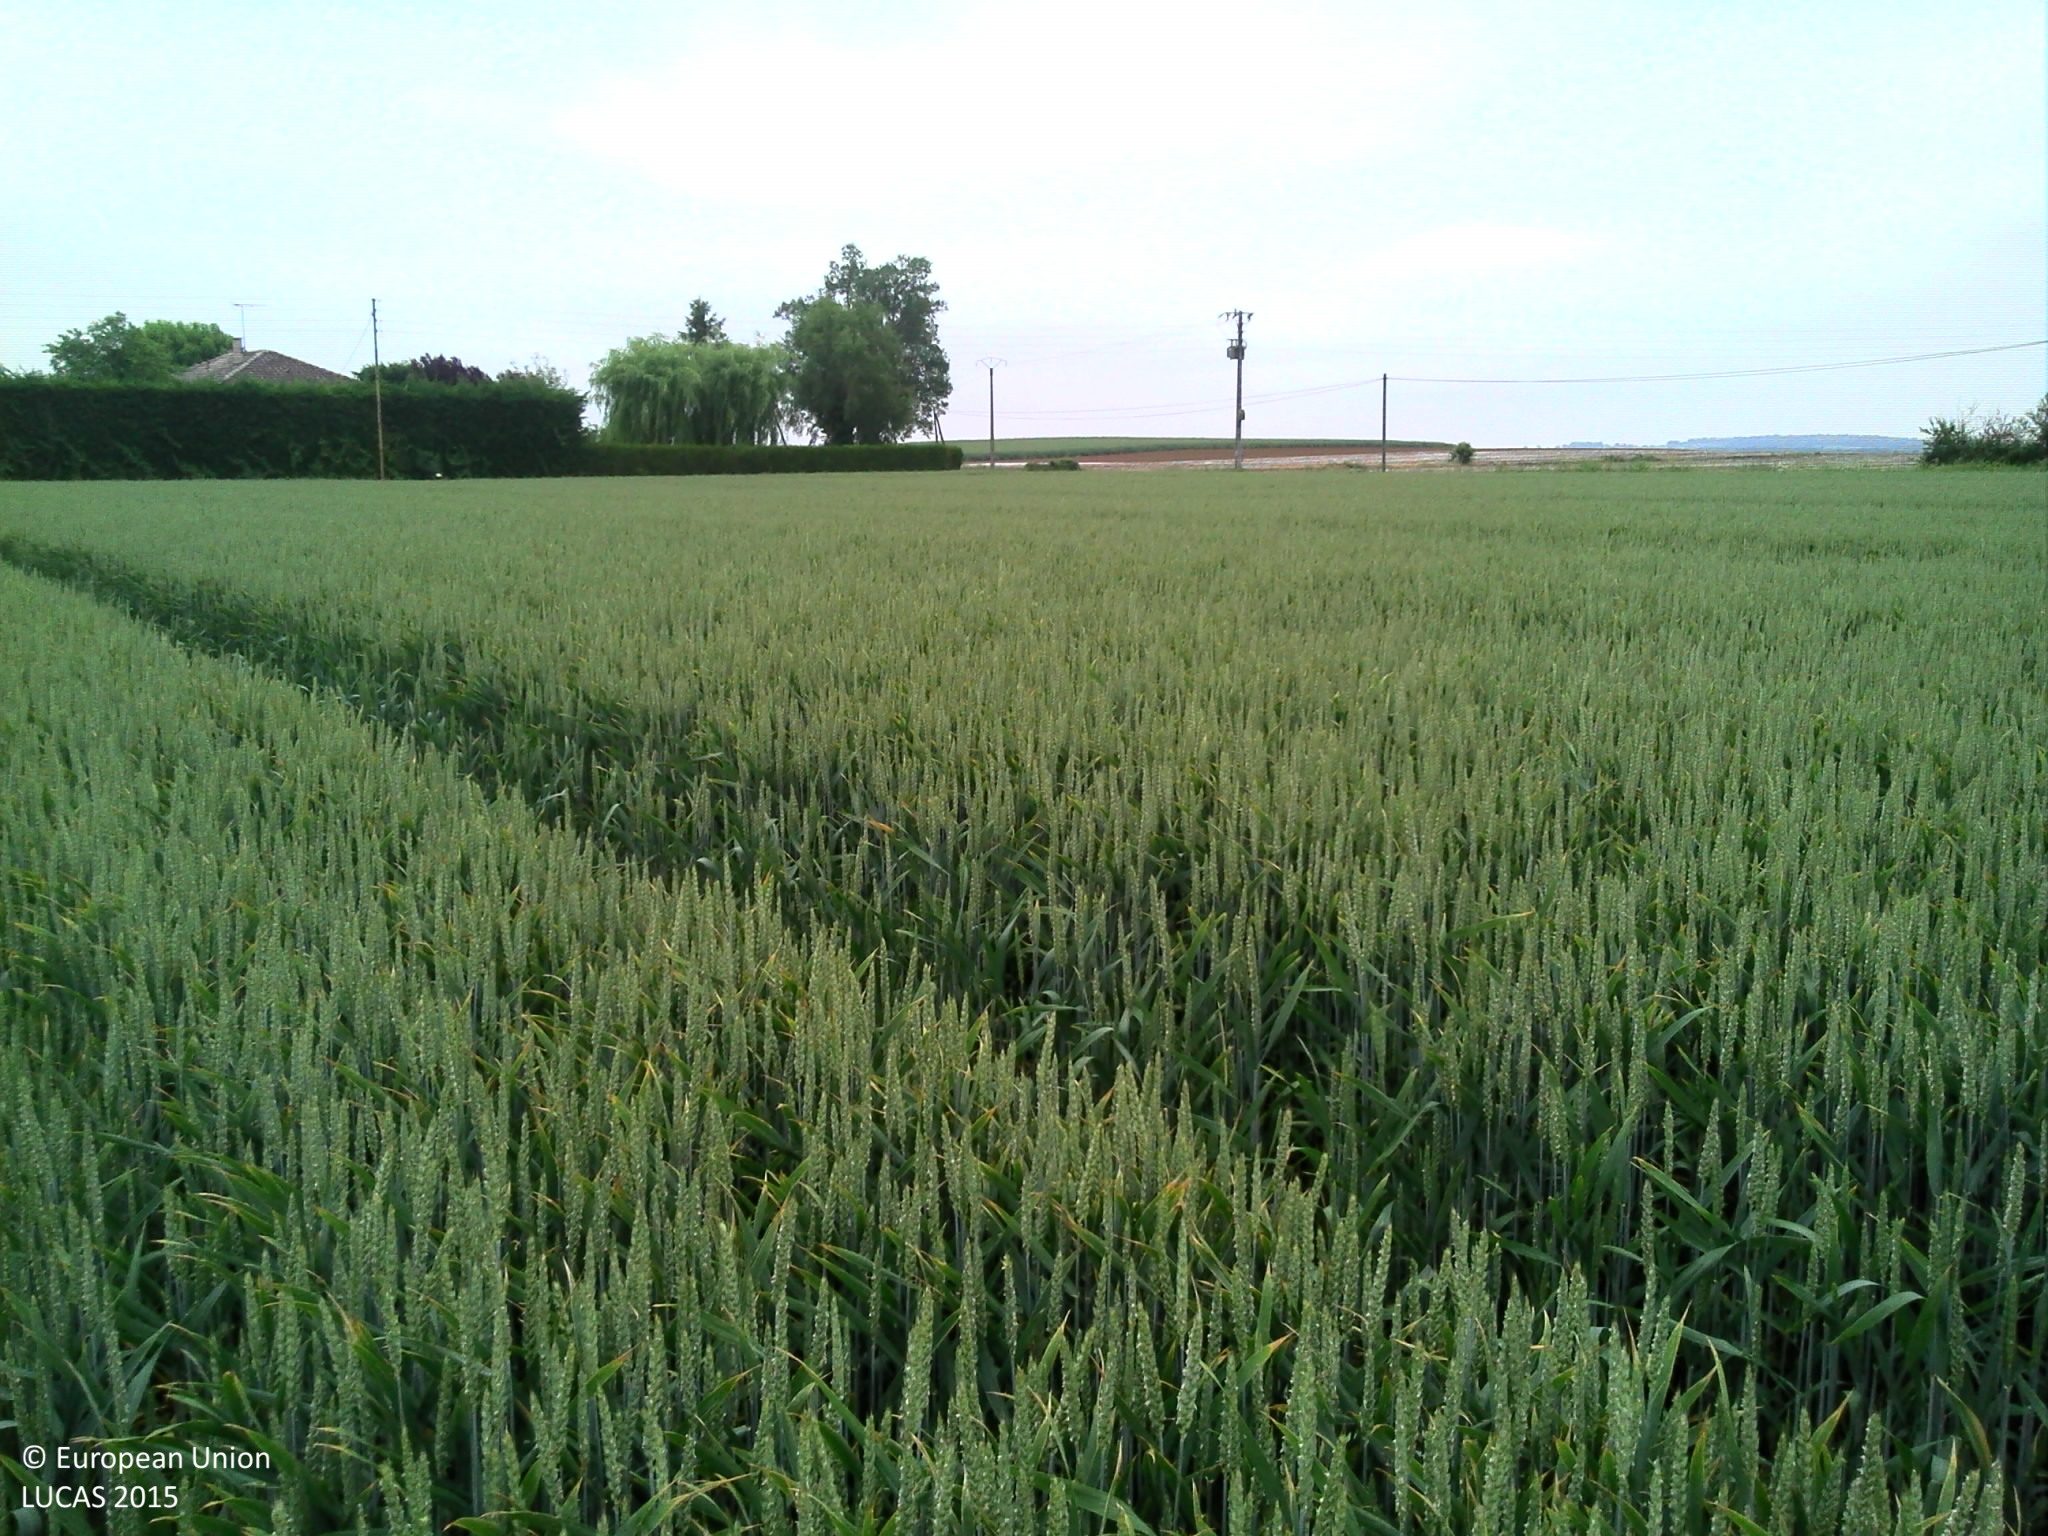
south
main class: Cropland
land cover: Common wheat
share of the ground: > 75 %
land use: Agriculture (excluding fallow land and kitchen gardens)
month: May
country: FR
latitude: 47.0686
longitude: 0.0875
